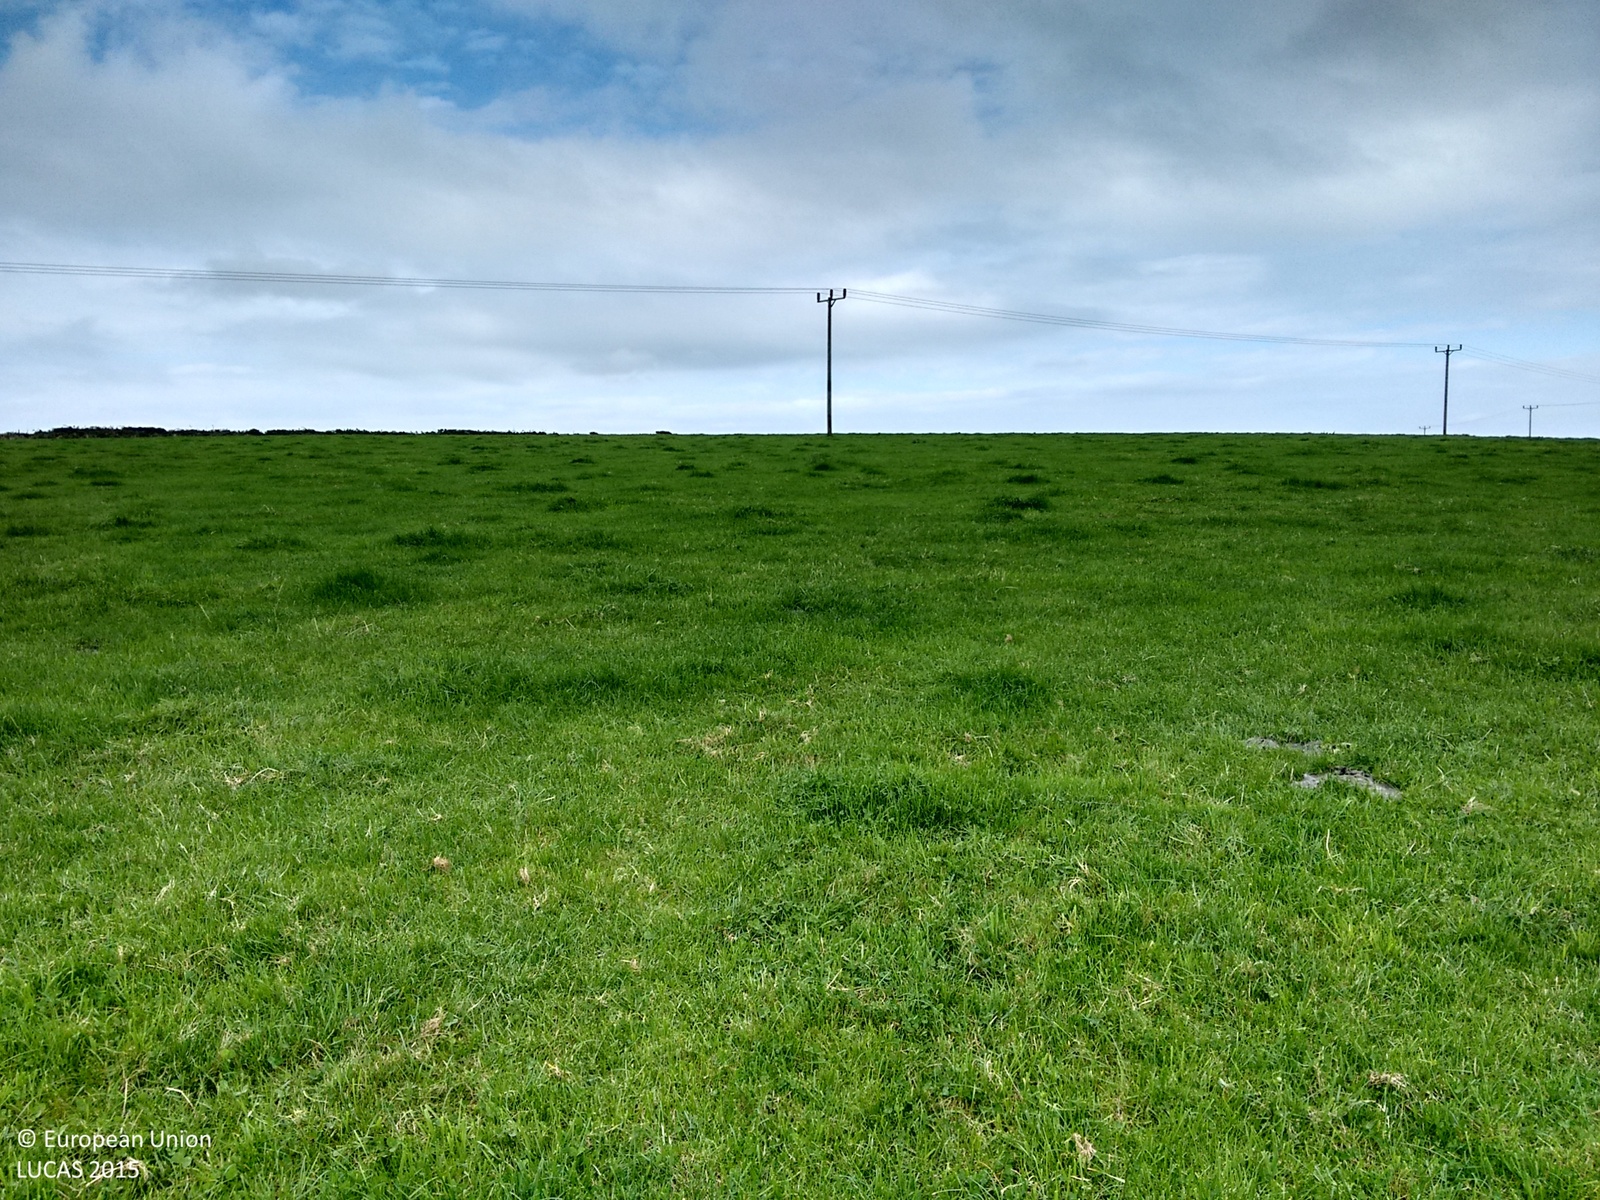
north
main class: Grassland
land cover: Grassland without tree/shrub cover
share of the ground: > 75 %
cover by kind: herbaceous plants 100 %
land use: Agriculture (excluding fallow land and kitchen gardens)
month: September
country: GB
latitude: 52.0969
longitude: -4.5433
